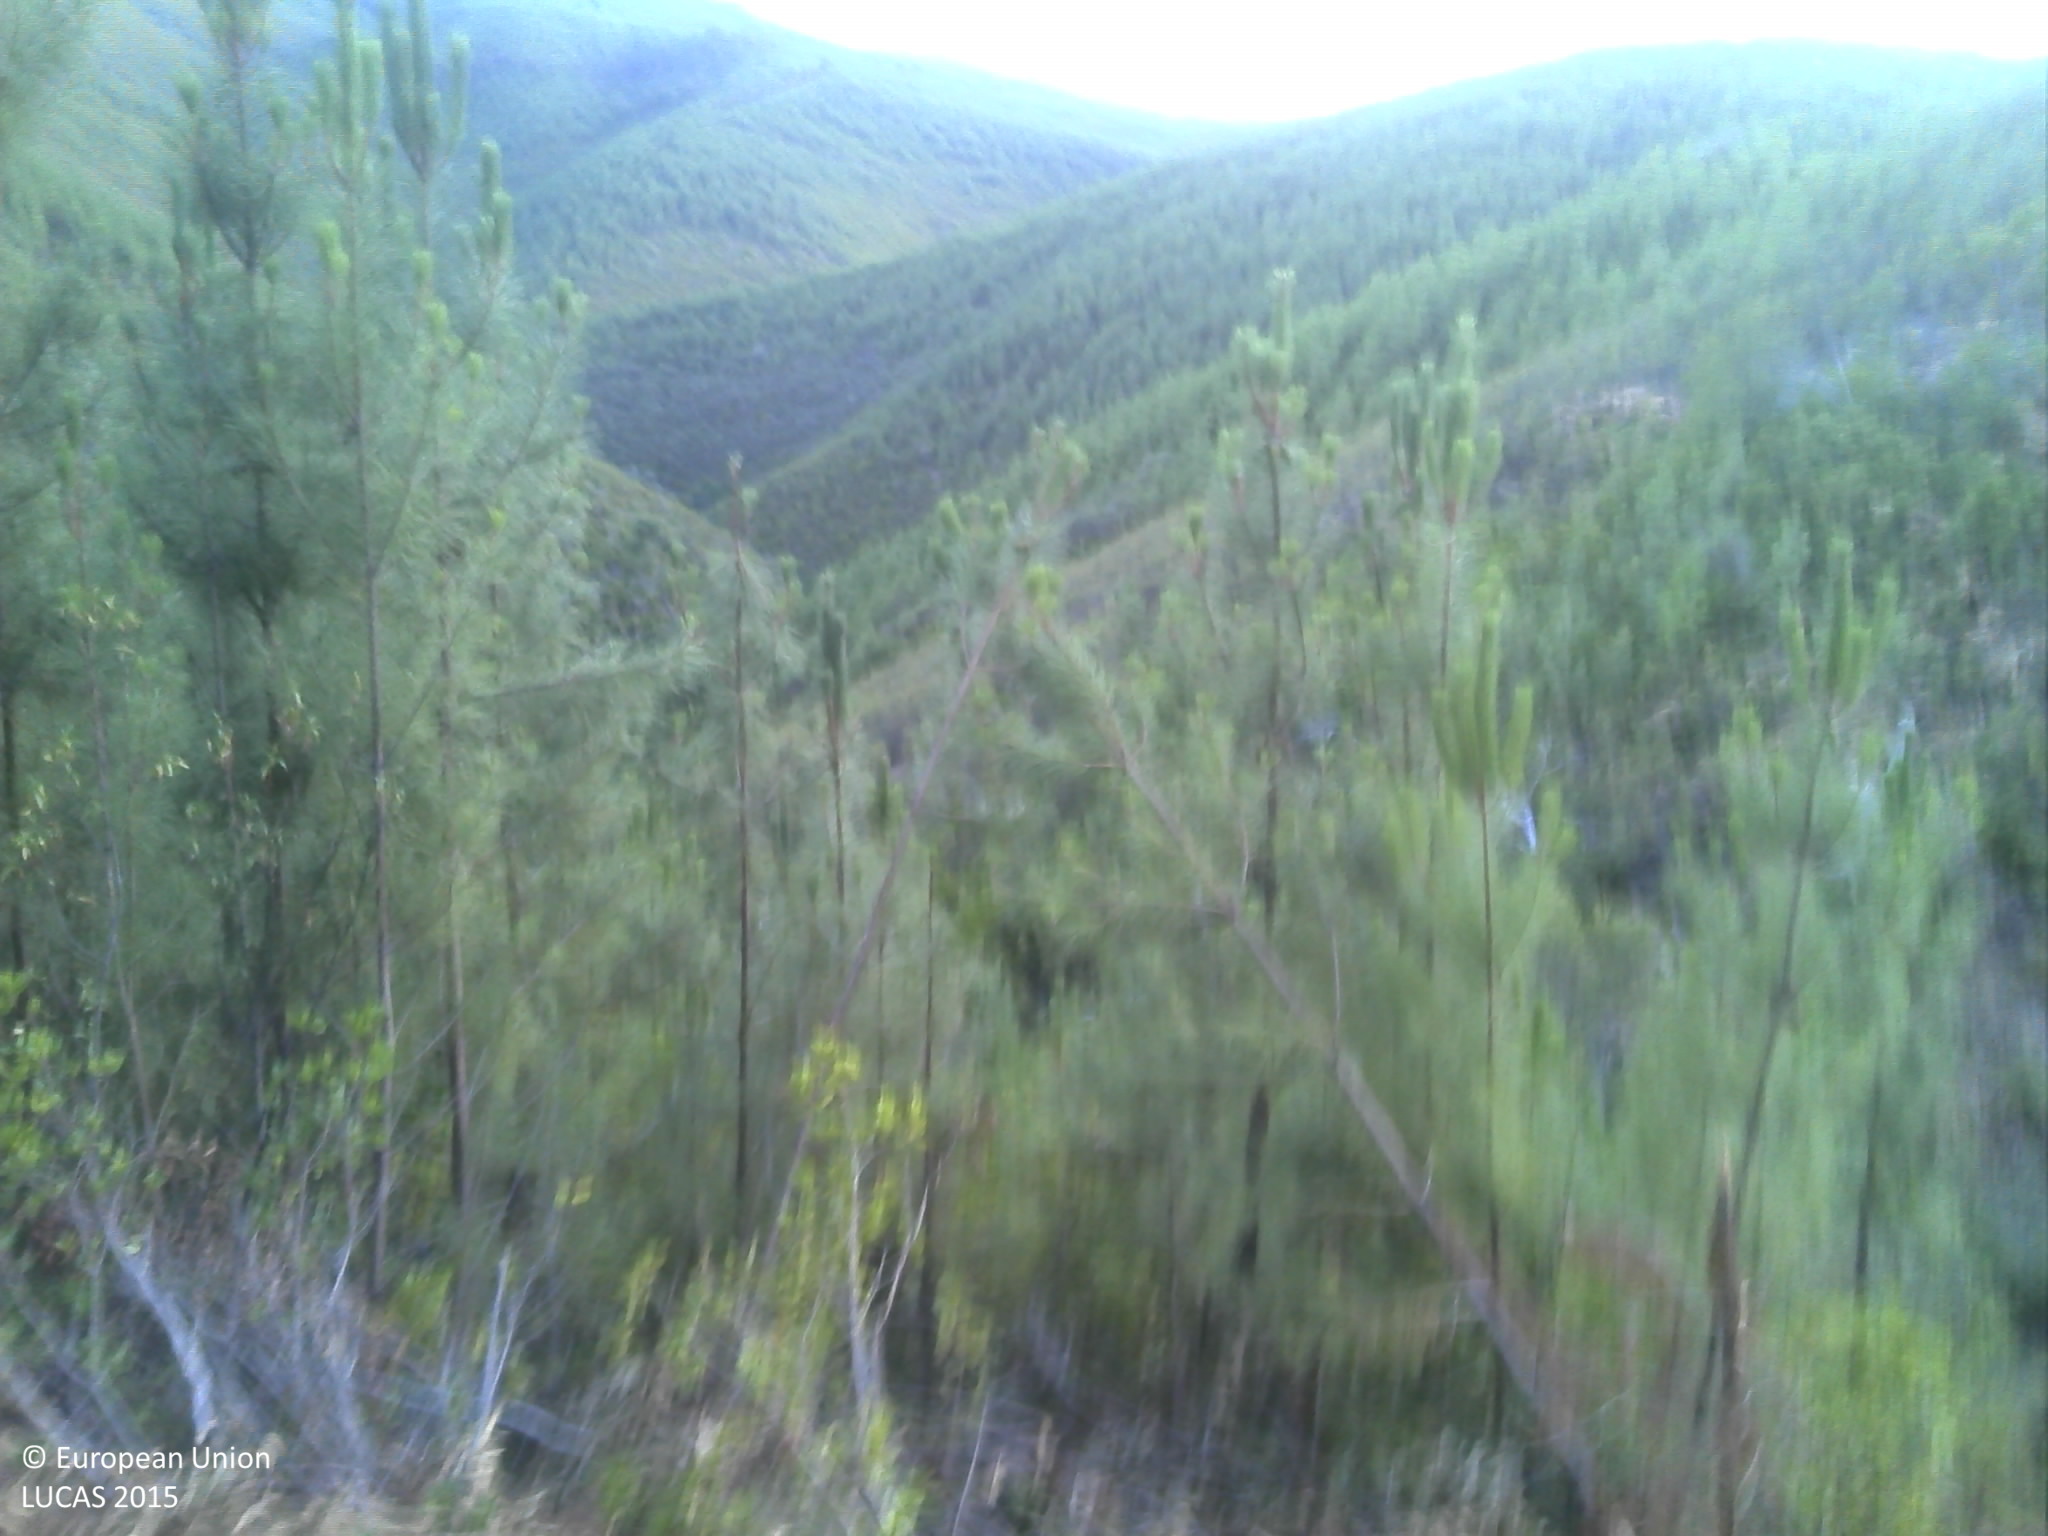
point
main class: Woodland
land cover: Pine dominated coniferous woodland
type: coniferous forest of the mediterranean region
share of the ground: 50 - 75 %
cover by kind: coniferous forest trees 50 %, shrubs 30 %, unconsolidated bare surface 20 %
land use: Forestry
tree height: < 5 m
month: July
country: PT
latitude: 39.8852
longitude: -7.7764
